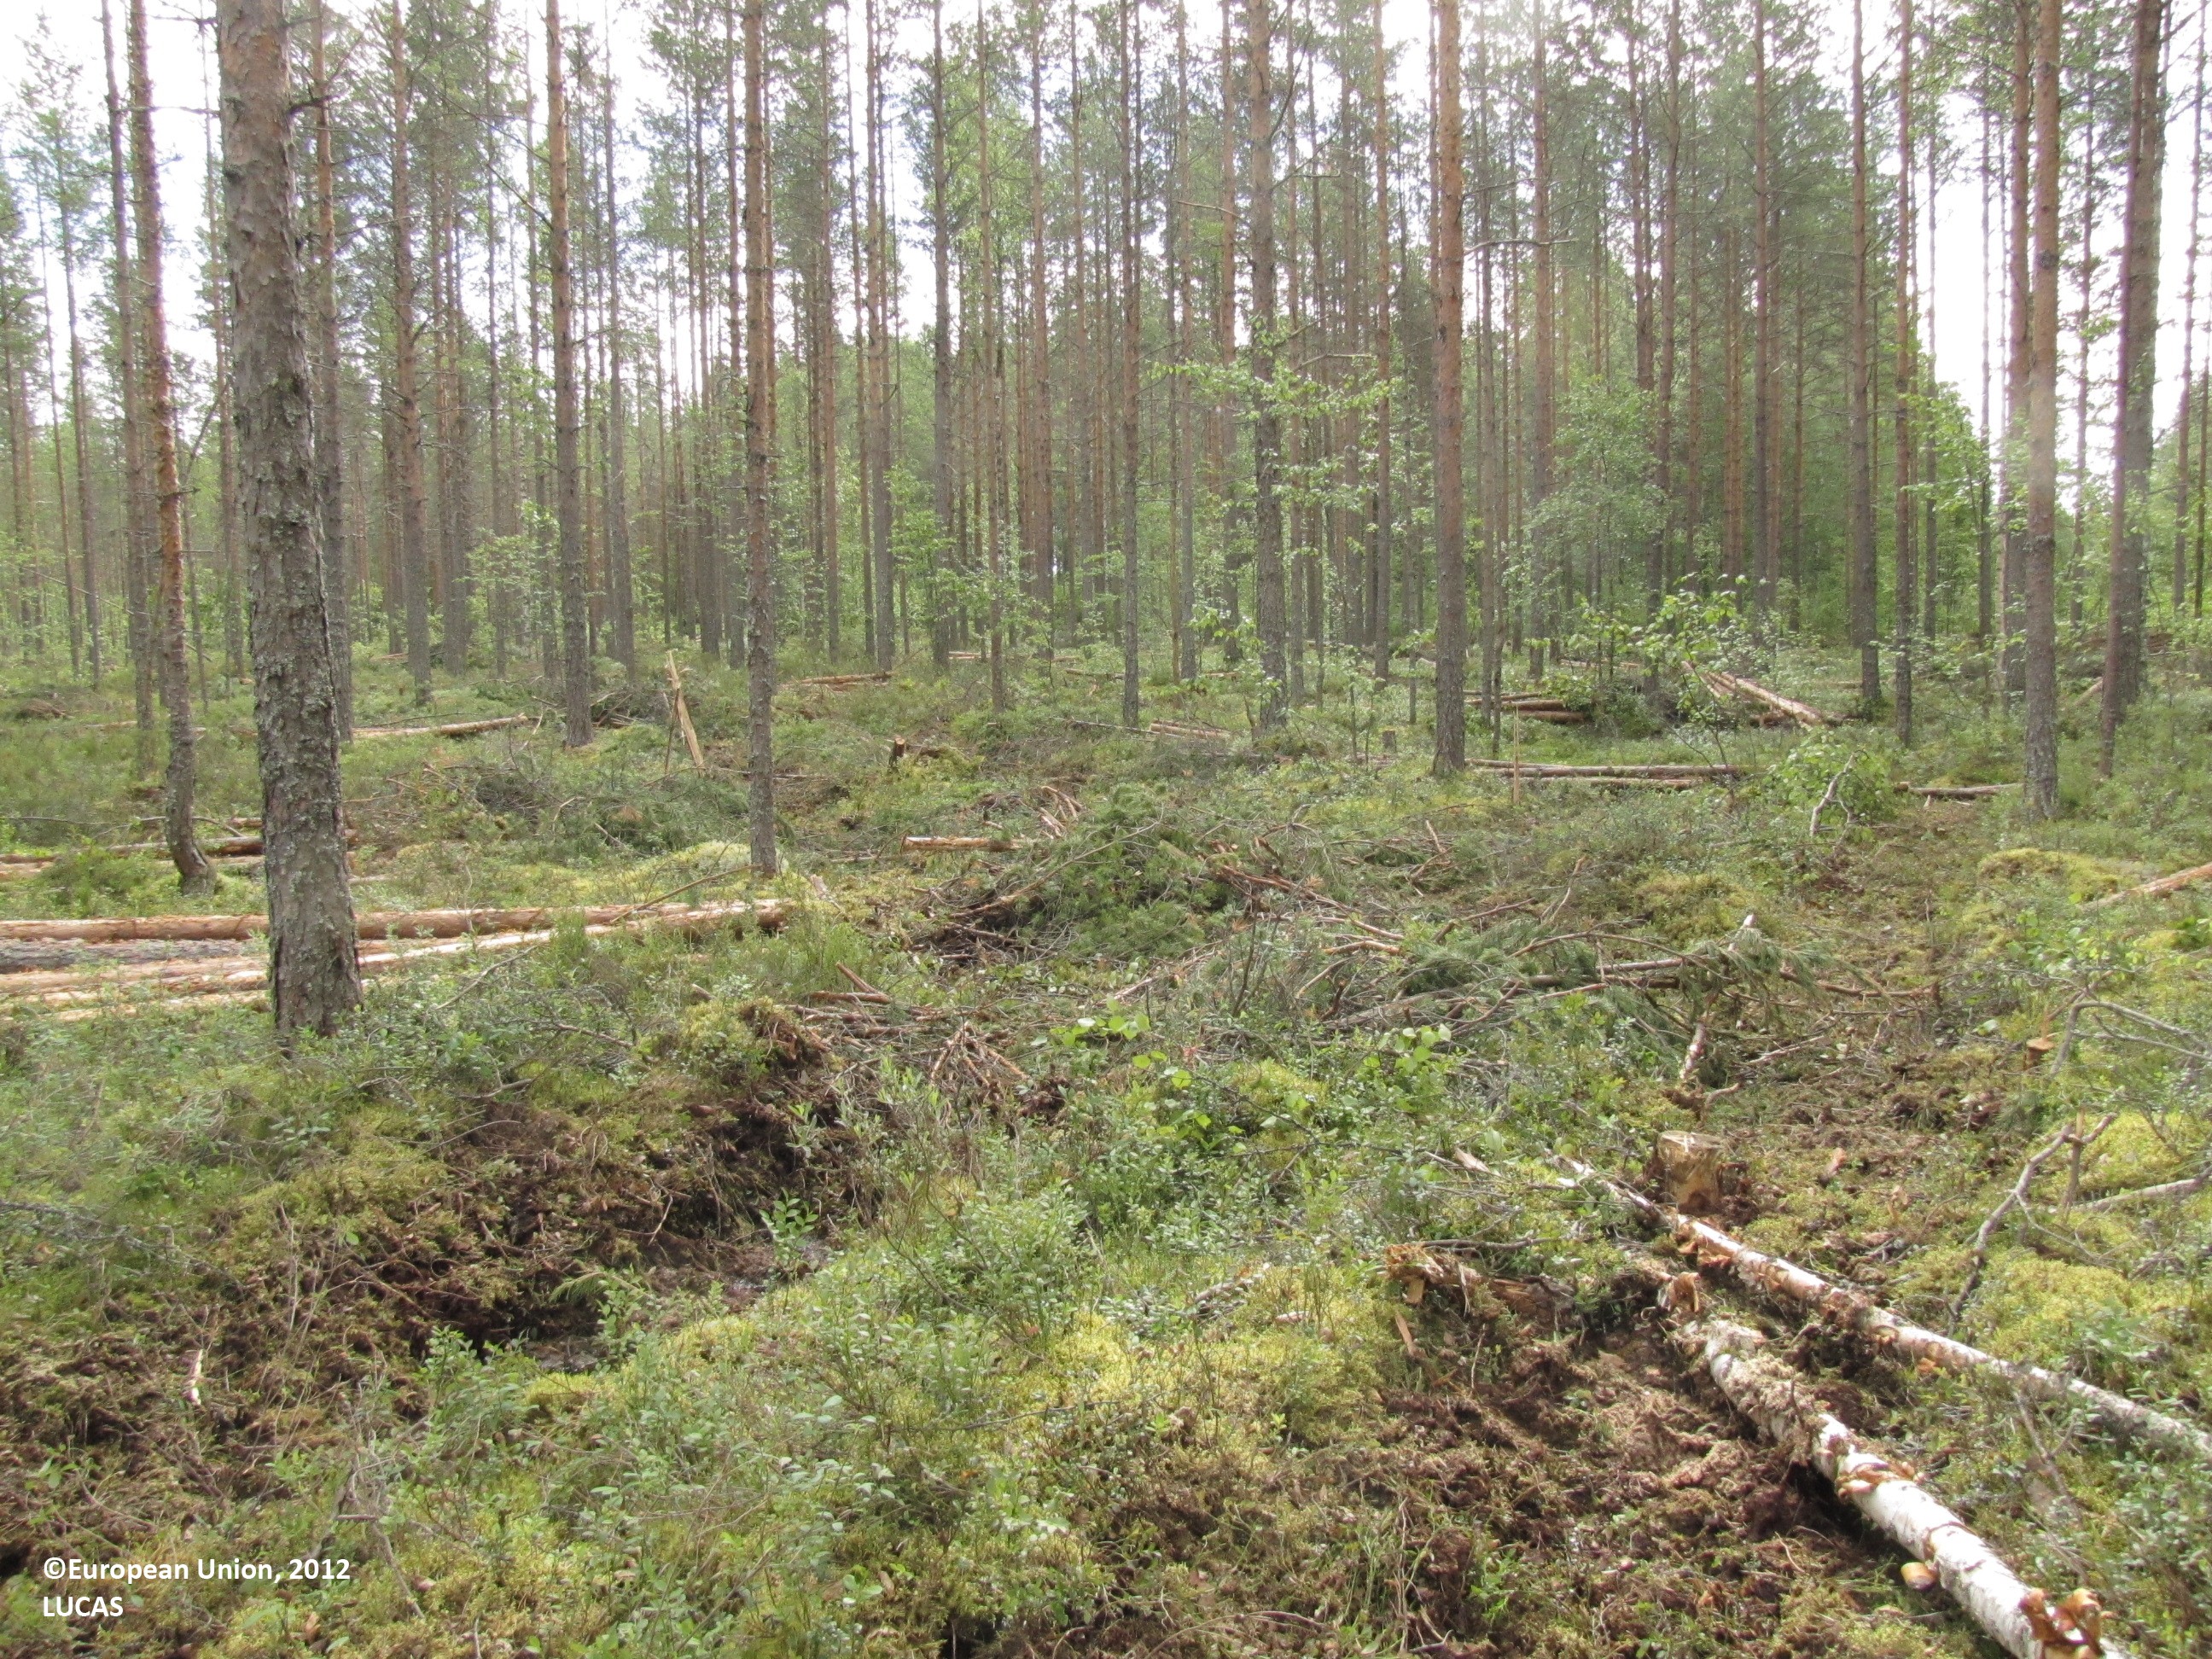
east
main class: Woodland
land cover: Pine dominated coniferous woodland
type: mire and swamp forests
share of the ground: 50 - 75 %
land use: Forestry
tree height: > 5 m
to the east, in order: Pine dominated coniferous woodland; Ditches and canals; Pine dominated coniferous woodland; Broadleaved woodland; Ditches and canals; Grass margins; Tracks; Electric lines; Pine dominated mixed woodland; Broadleaved woodland; Pine dominated mixed woodland; Electric lines; Pine dominated mixed woodland
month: July
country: FI
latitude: 62.3700
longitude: 23.2698
